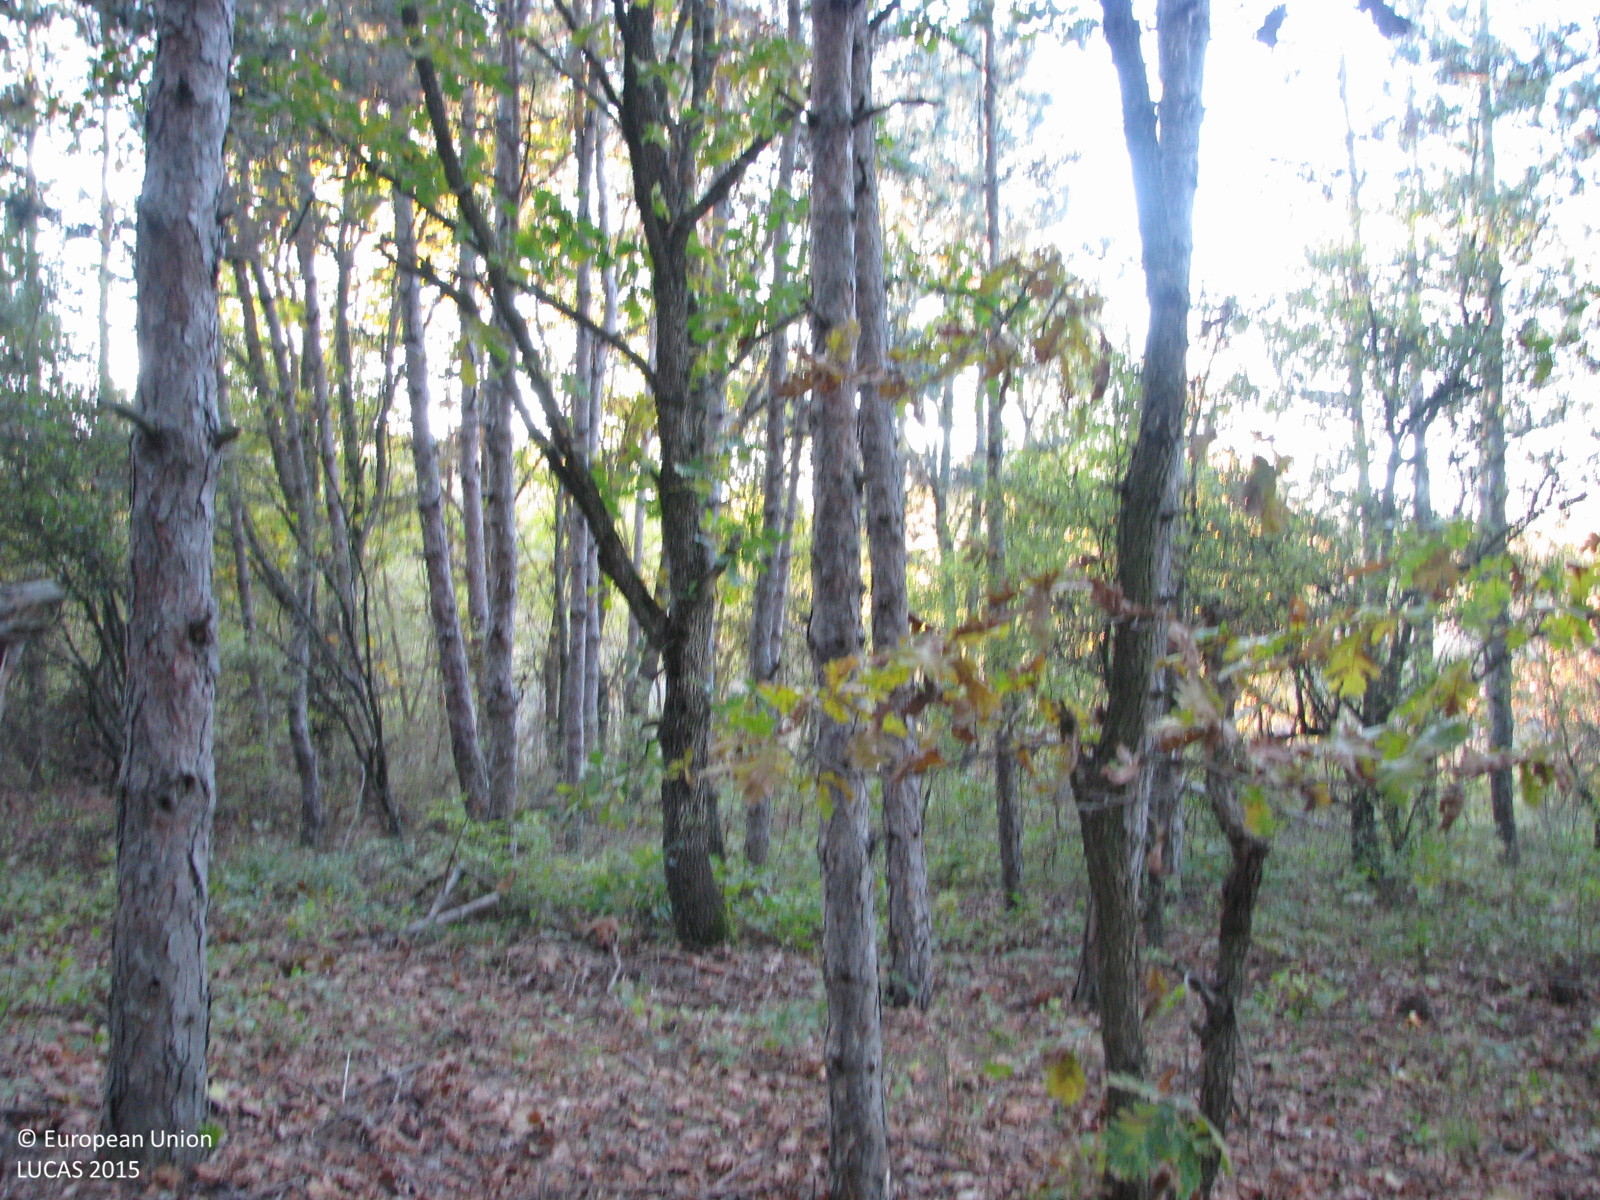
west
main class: Woodland
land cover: Pine dominated mixed woodland
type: hemiboreal forest and nemoral coniferous forest and mixed broadleaved-coniferous forest
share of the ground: > 75 %
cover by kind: coniferous forest trees 60 %, broadleaved forest trees 25 %, herbaceous plants 10 %, shrubs 5 %
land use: Forestry
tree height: > 5 m
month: November
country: BG
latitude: 42.1417
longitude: 26.9038
